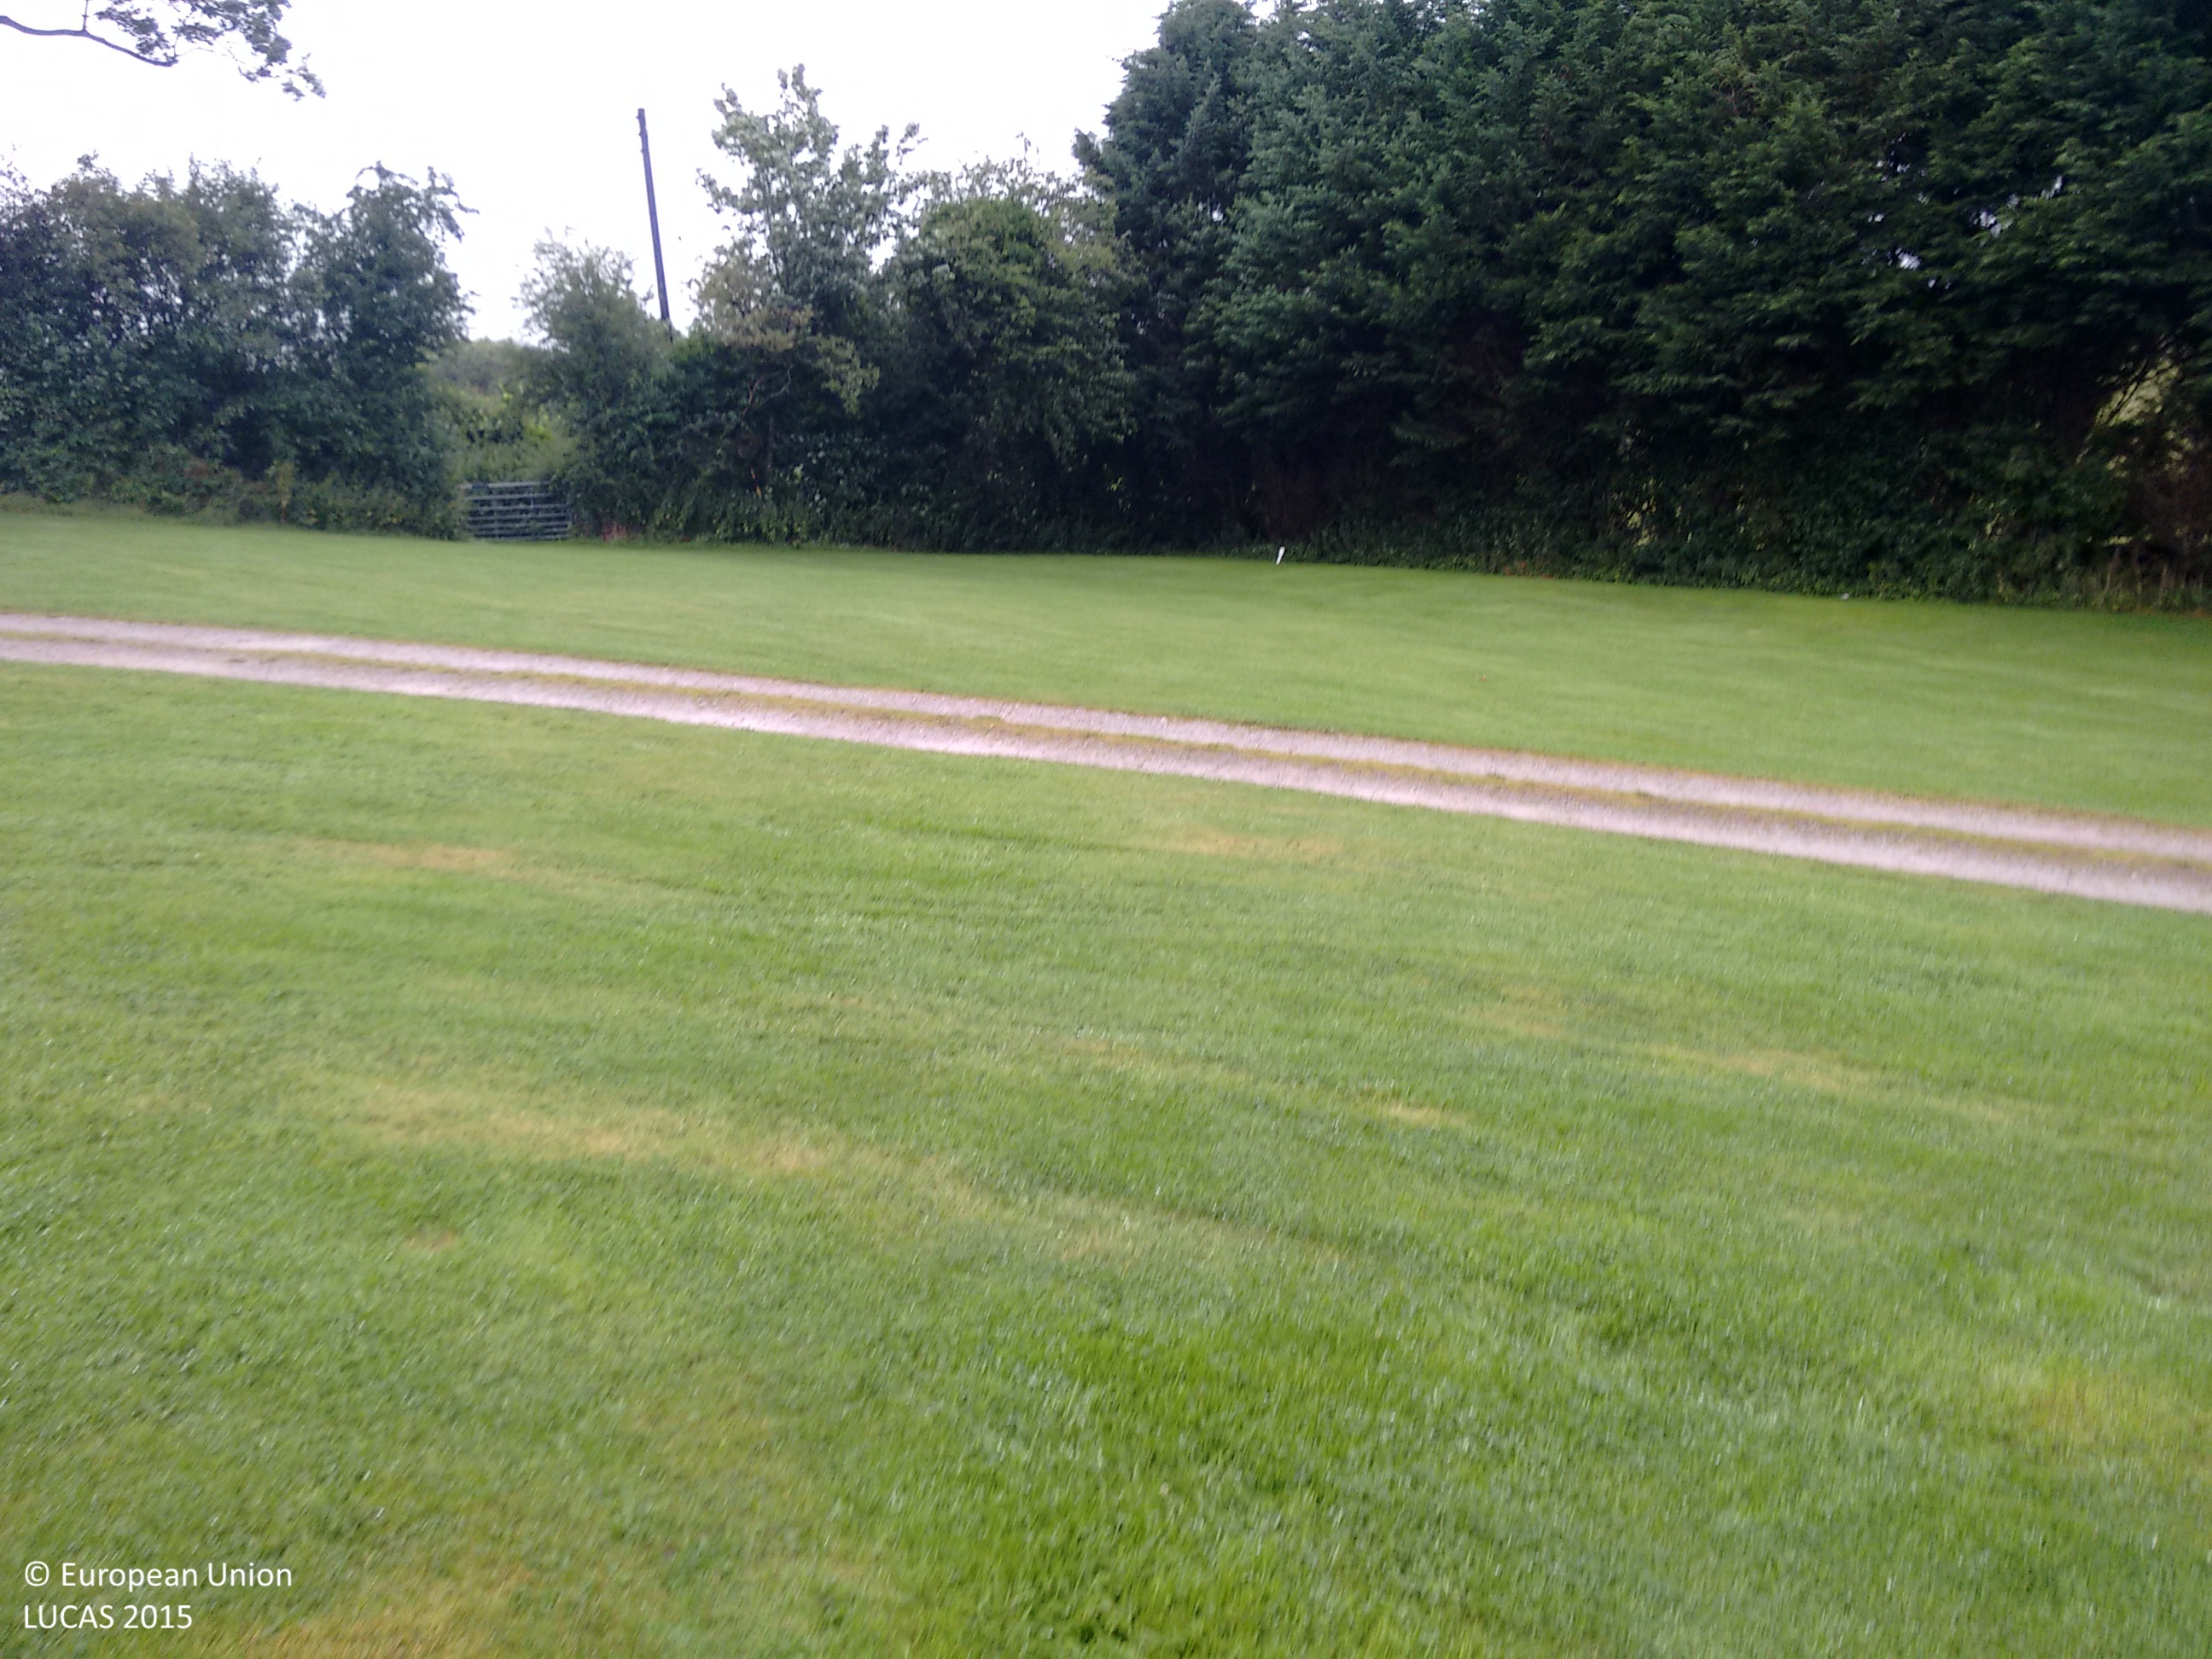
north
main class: Grassland
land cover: Grassland without tree/shrub cover
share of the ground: > 75 %
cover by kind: herbaceous plants 100 %
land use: Amenities, museums, leisure
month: August
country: GB
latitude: 54.3478
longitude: -2.7292
